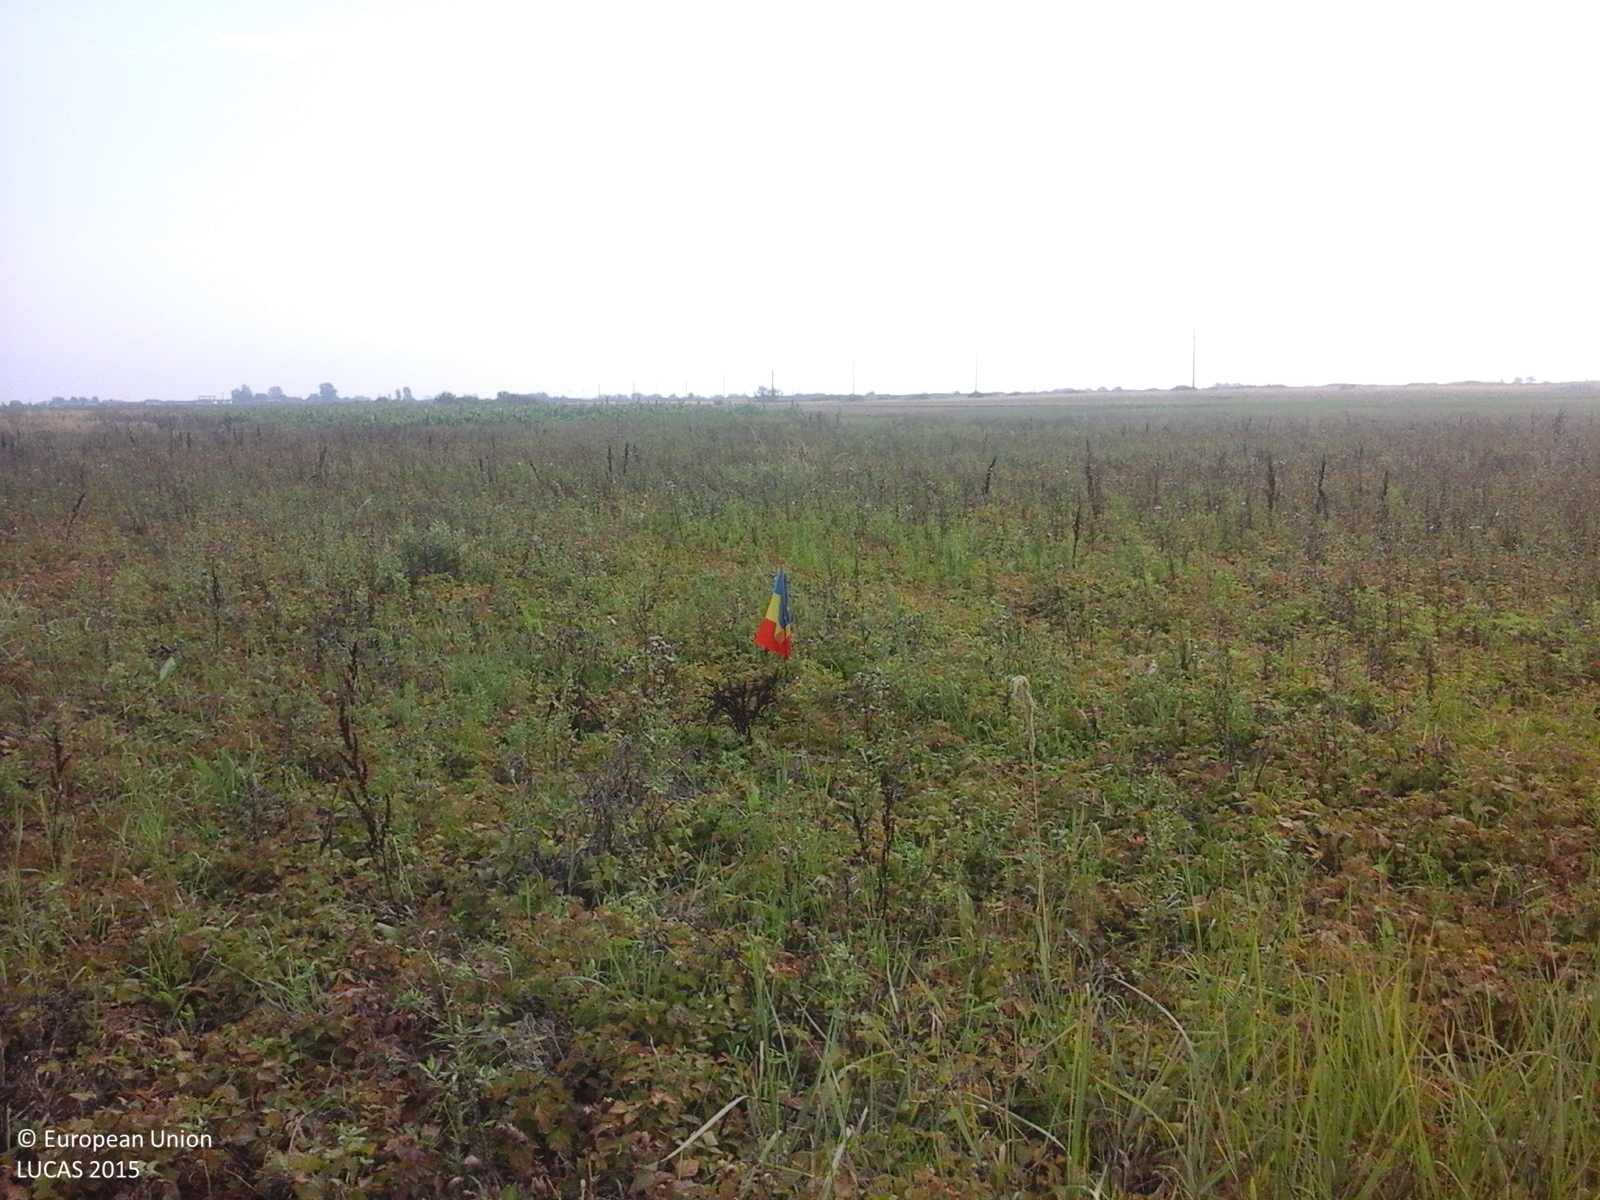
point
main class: Grassland
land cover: Spontaneously vegetated surfaces
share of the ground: > 75 %
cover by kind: herbaceous plants 100 %
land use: Fallow land
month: August
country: RO
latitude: 46.4122
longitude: 21.7357
